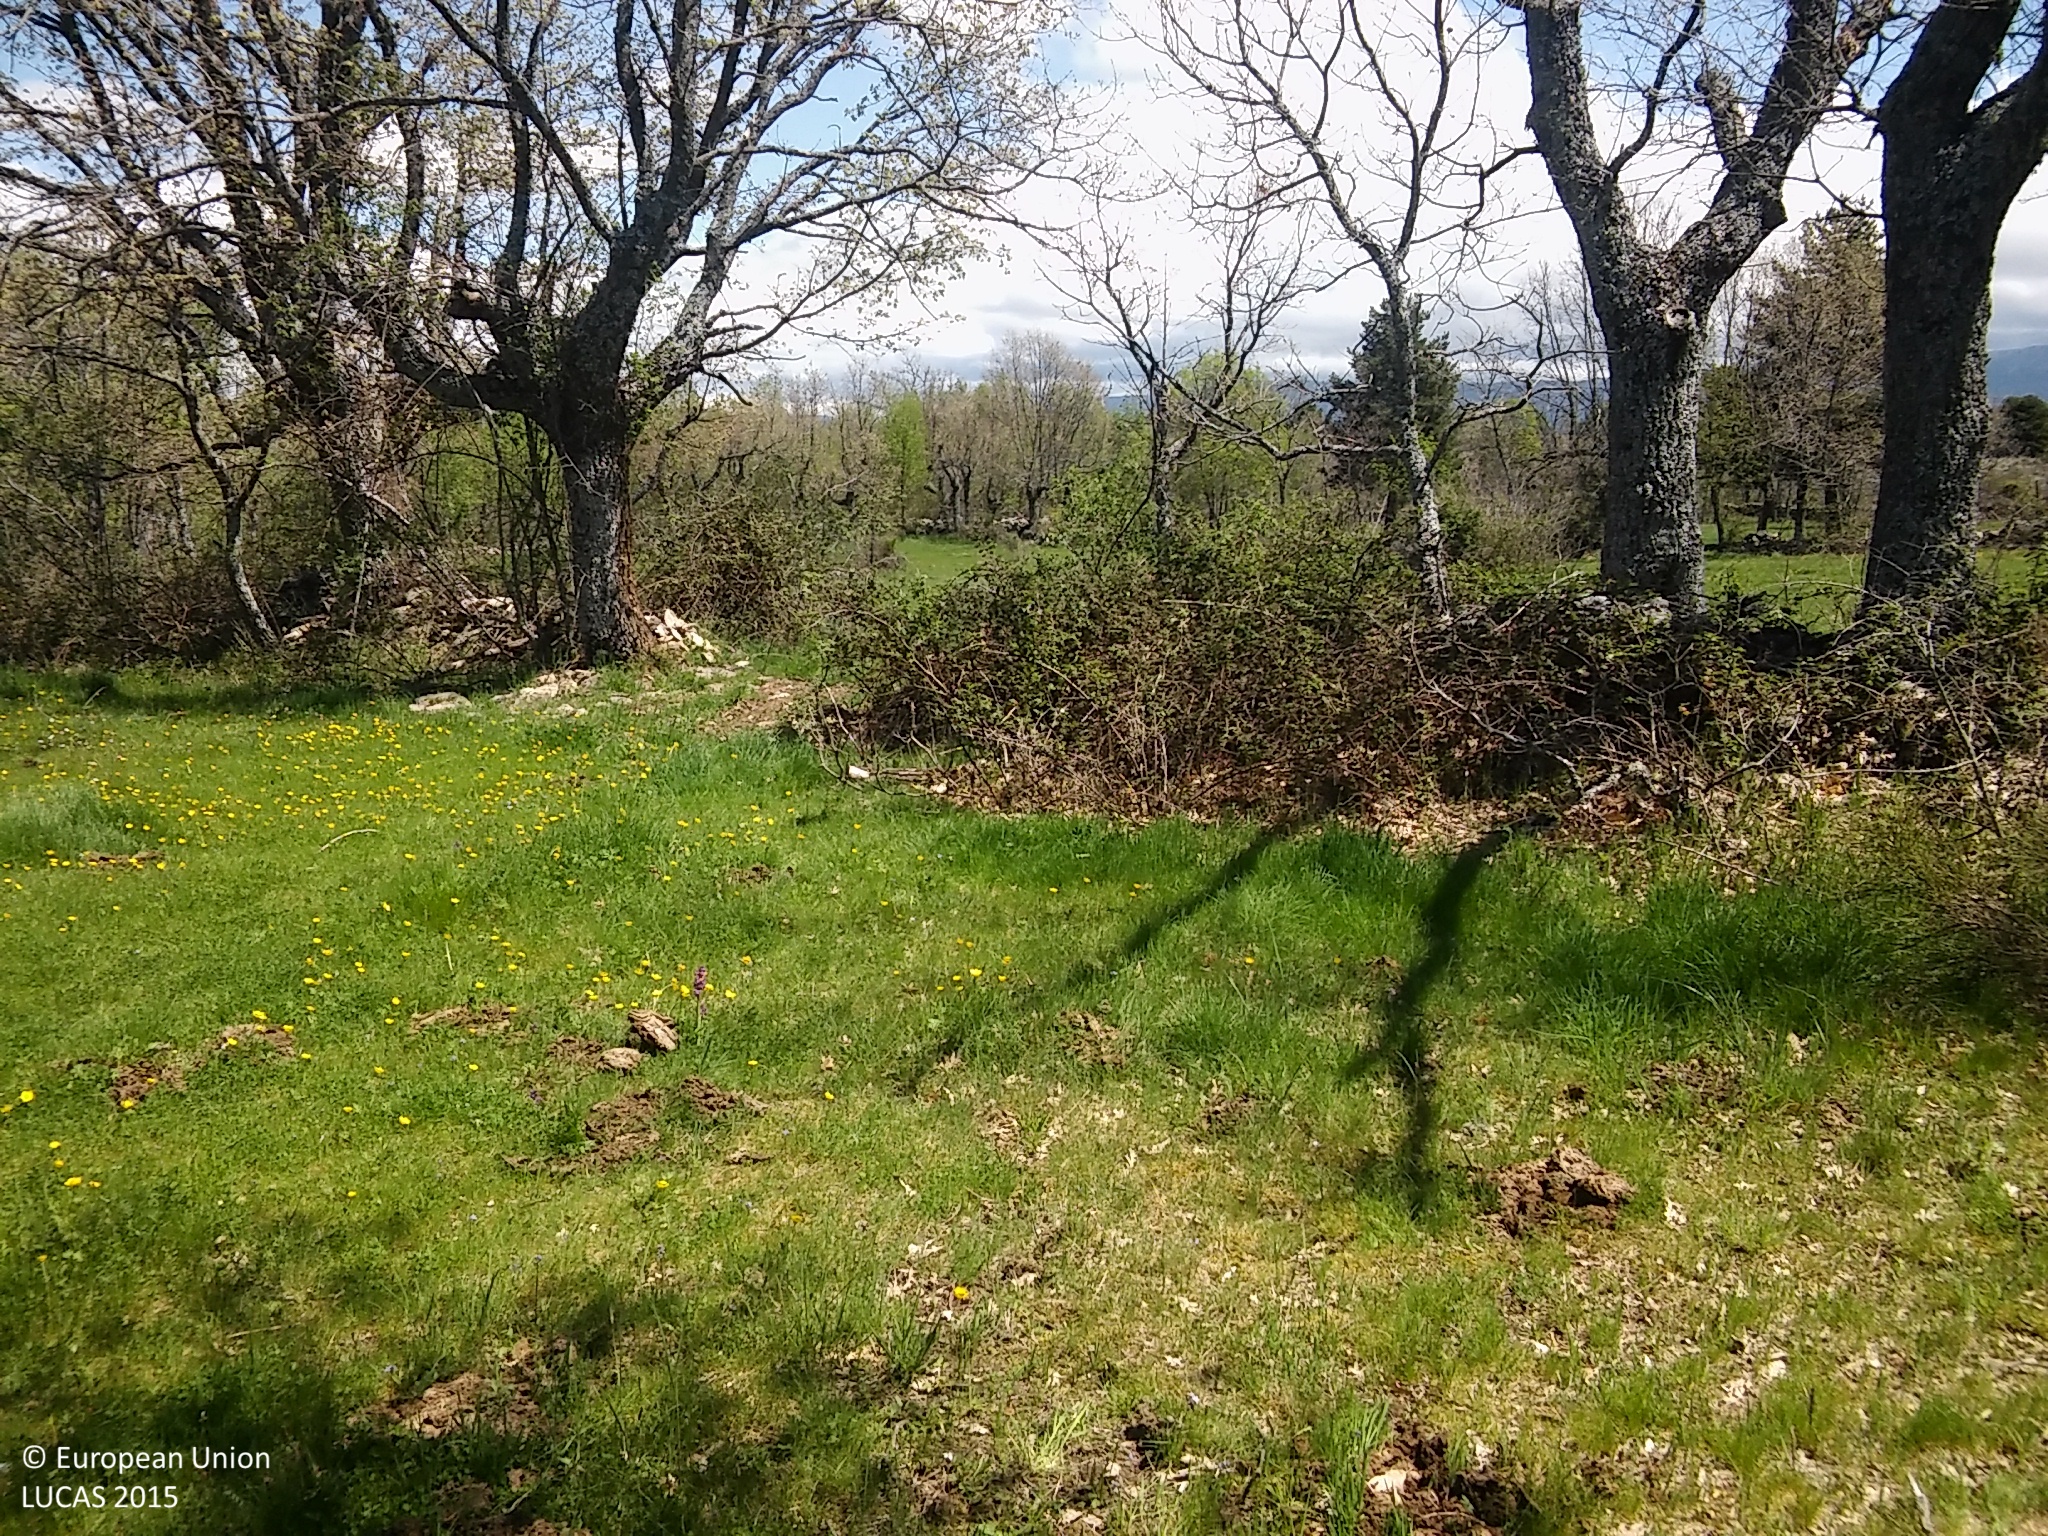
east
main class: Woodland
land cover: Broadleaved woodland
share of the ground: 25 - 50 %
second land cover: Grassland without tree/shrub cover
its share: > 75 %
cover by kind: herbaceous plants 50 %, broadleaved forest trees 45 %, shrubs 5 %
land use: Forestry
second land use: Agriculture (excluding fallow land and kitchen gardens)
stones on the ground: 10 - 25 %
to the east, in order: Broadleaved woodland; Grassland without tree/shrub cover; Dry stone walls; Broadleaved woodland; Grassland with sparse tree/shrub cover; Dry stone walls; Groves; Grassland with sparse tree/shrub cover; Dry stone walls; Groves; Tracks; Groves; Broadleaved woodland; Grassland with sparse tree/shrub cover; Groves; Dry stone walls; Grass margins; Tracks; Shrubland with sparse tree cover
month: May
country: ES
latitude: 41.0695
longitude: -3.8893
